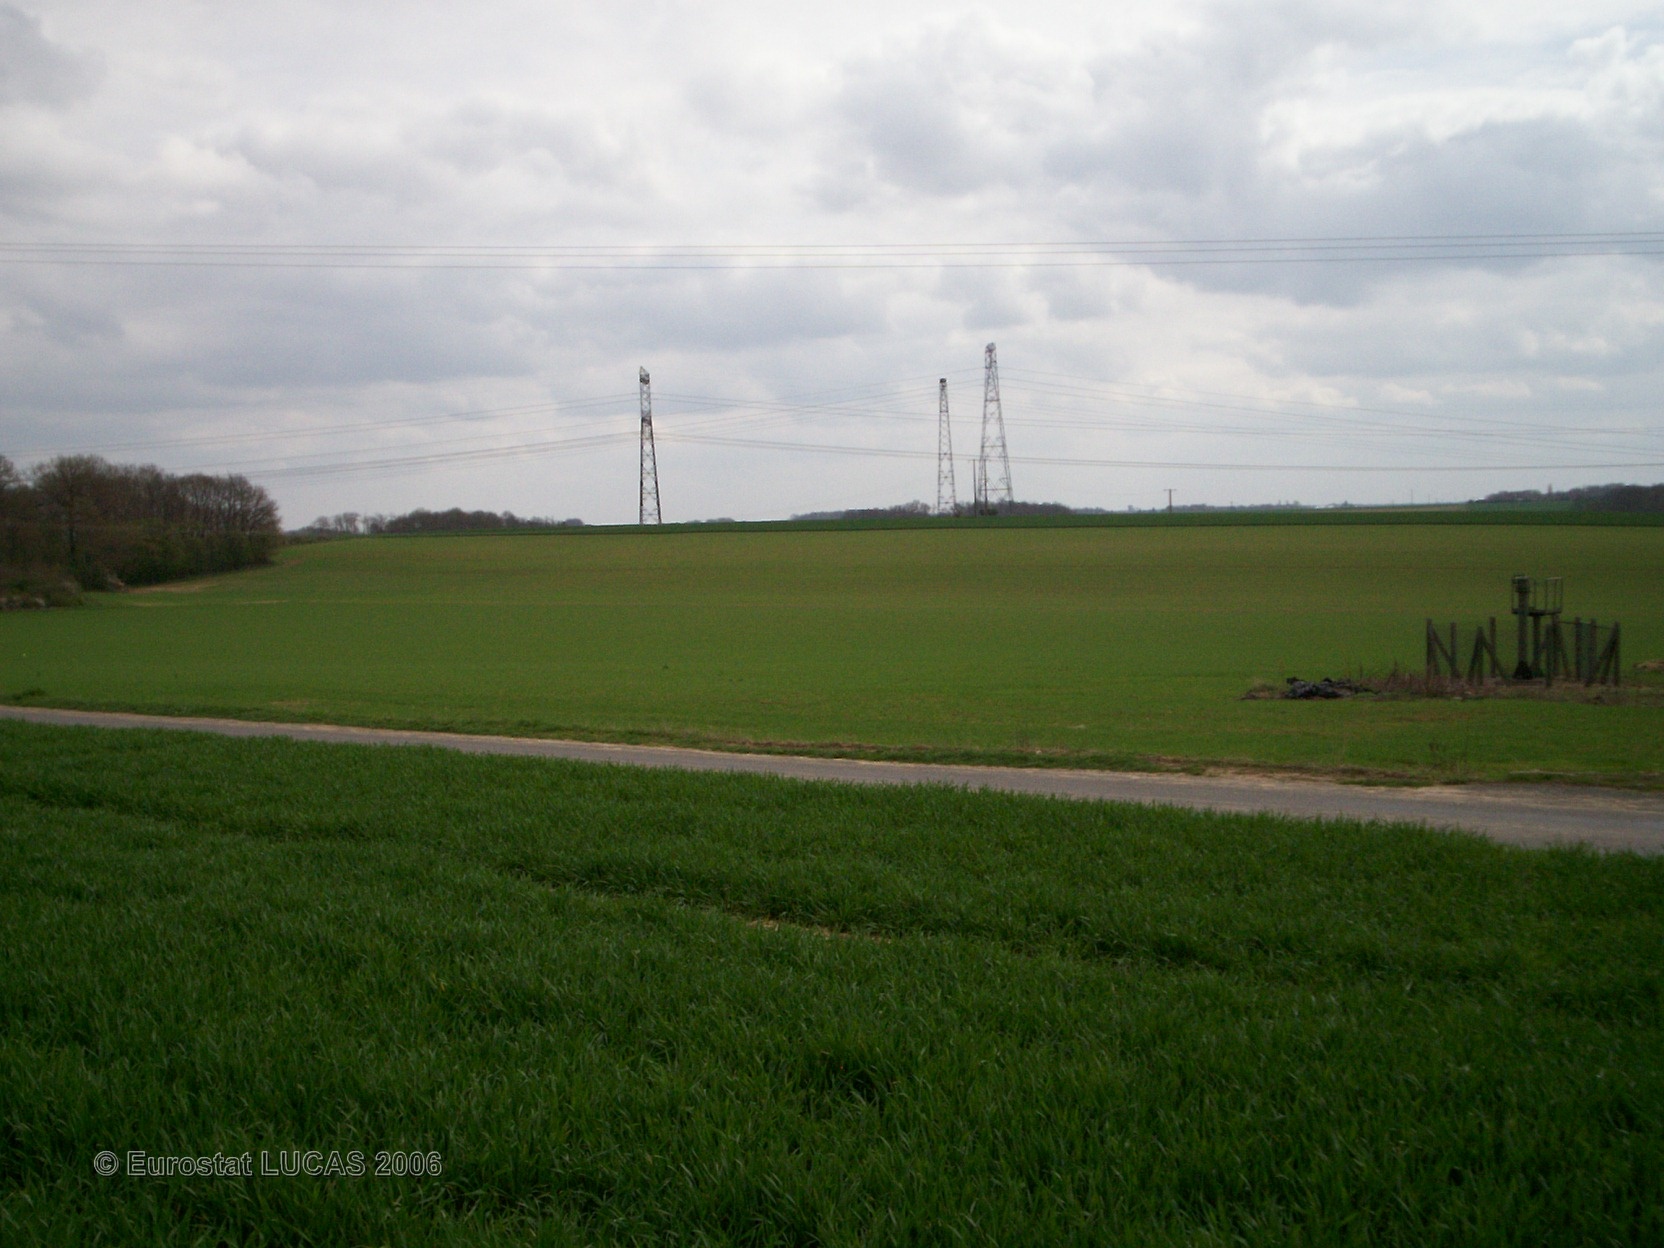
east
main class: Cropland
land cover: Common wheat
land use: Agriculture (excluding fallow land and kitchen gardens)
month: April
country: FR
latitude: 48.2615
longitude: 2.8387
